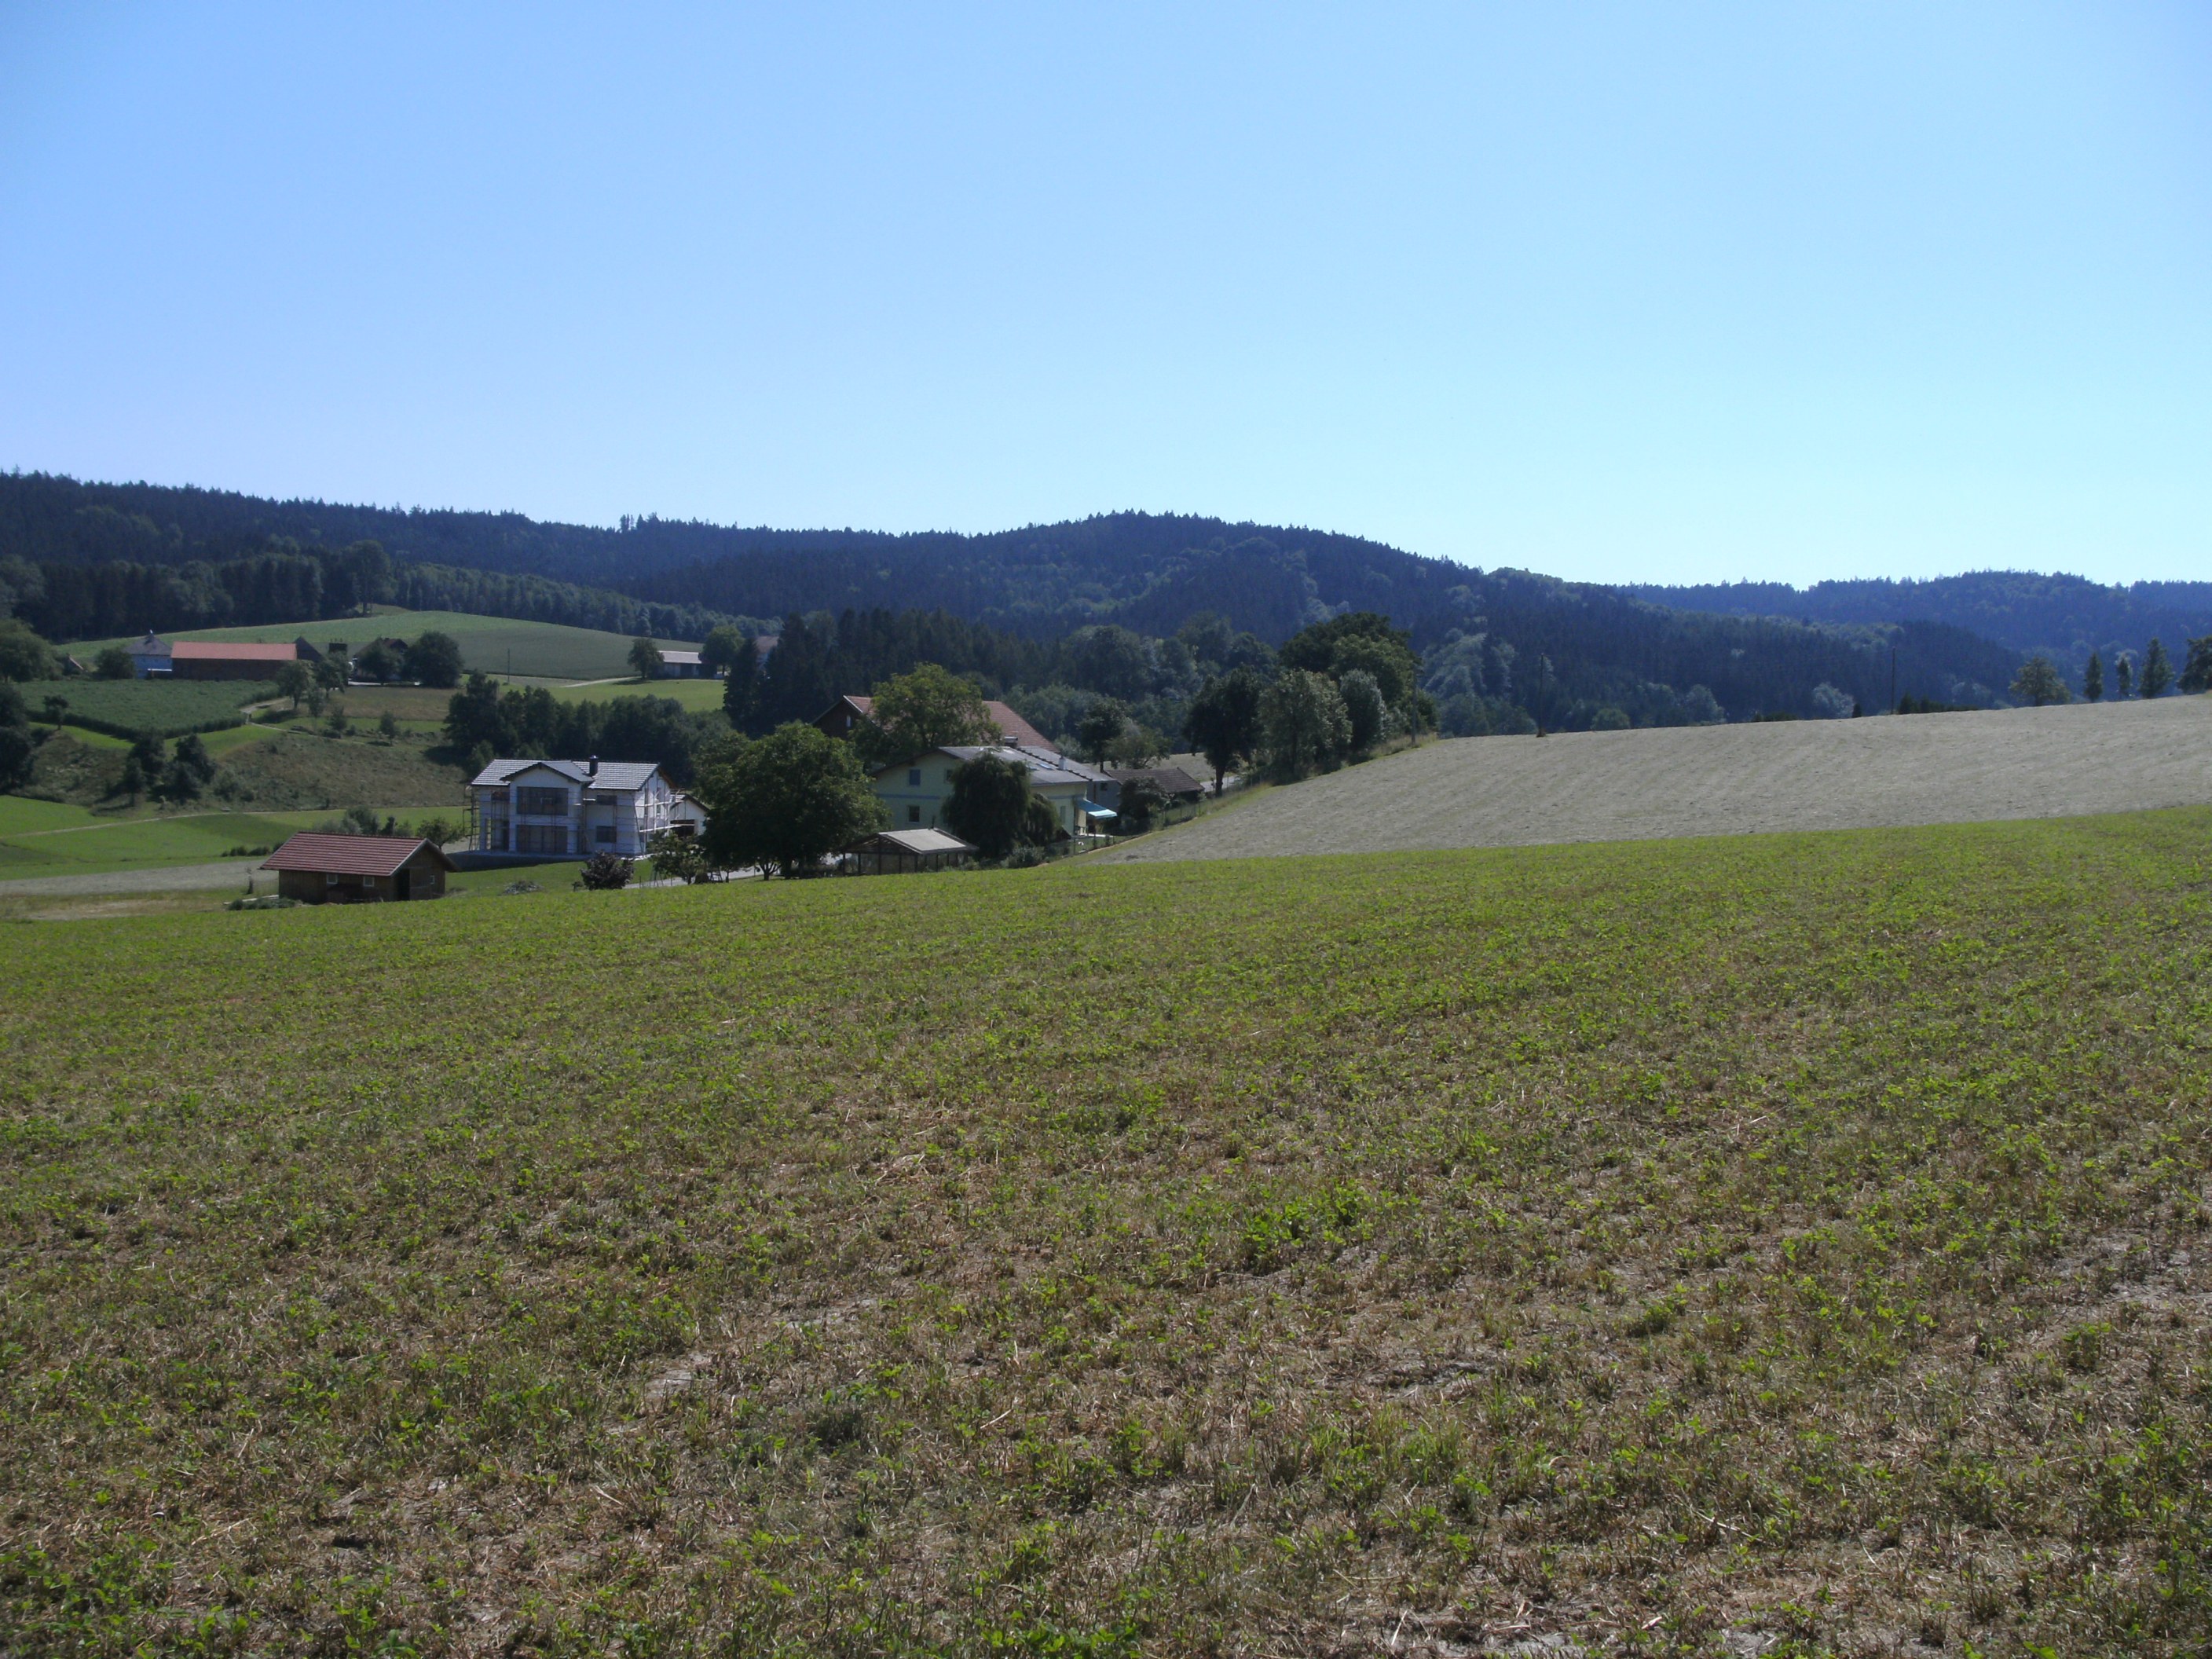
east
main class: Cropland
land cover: Common wheat
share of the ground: > 75 %
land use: Agriculture (excluding fallow land and kitchen gardens)
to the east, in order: Grass margins; Temporary grasslands; Grassland without tree/shrub cover; Artificial constructions in urban areas
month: July
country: AT
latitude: 48.1318
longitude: 13.5062
